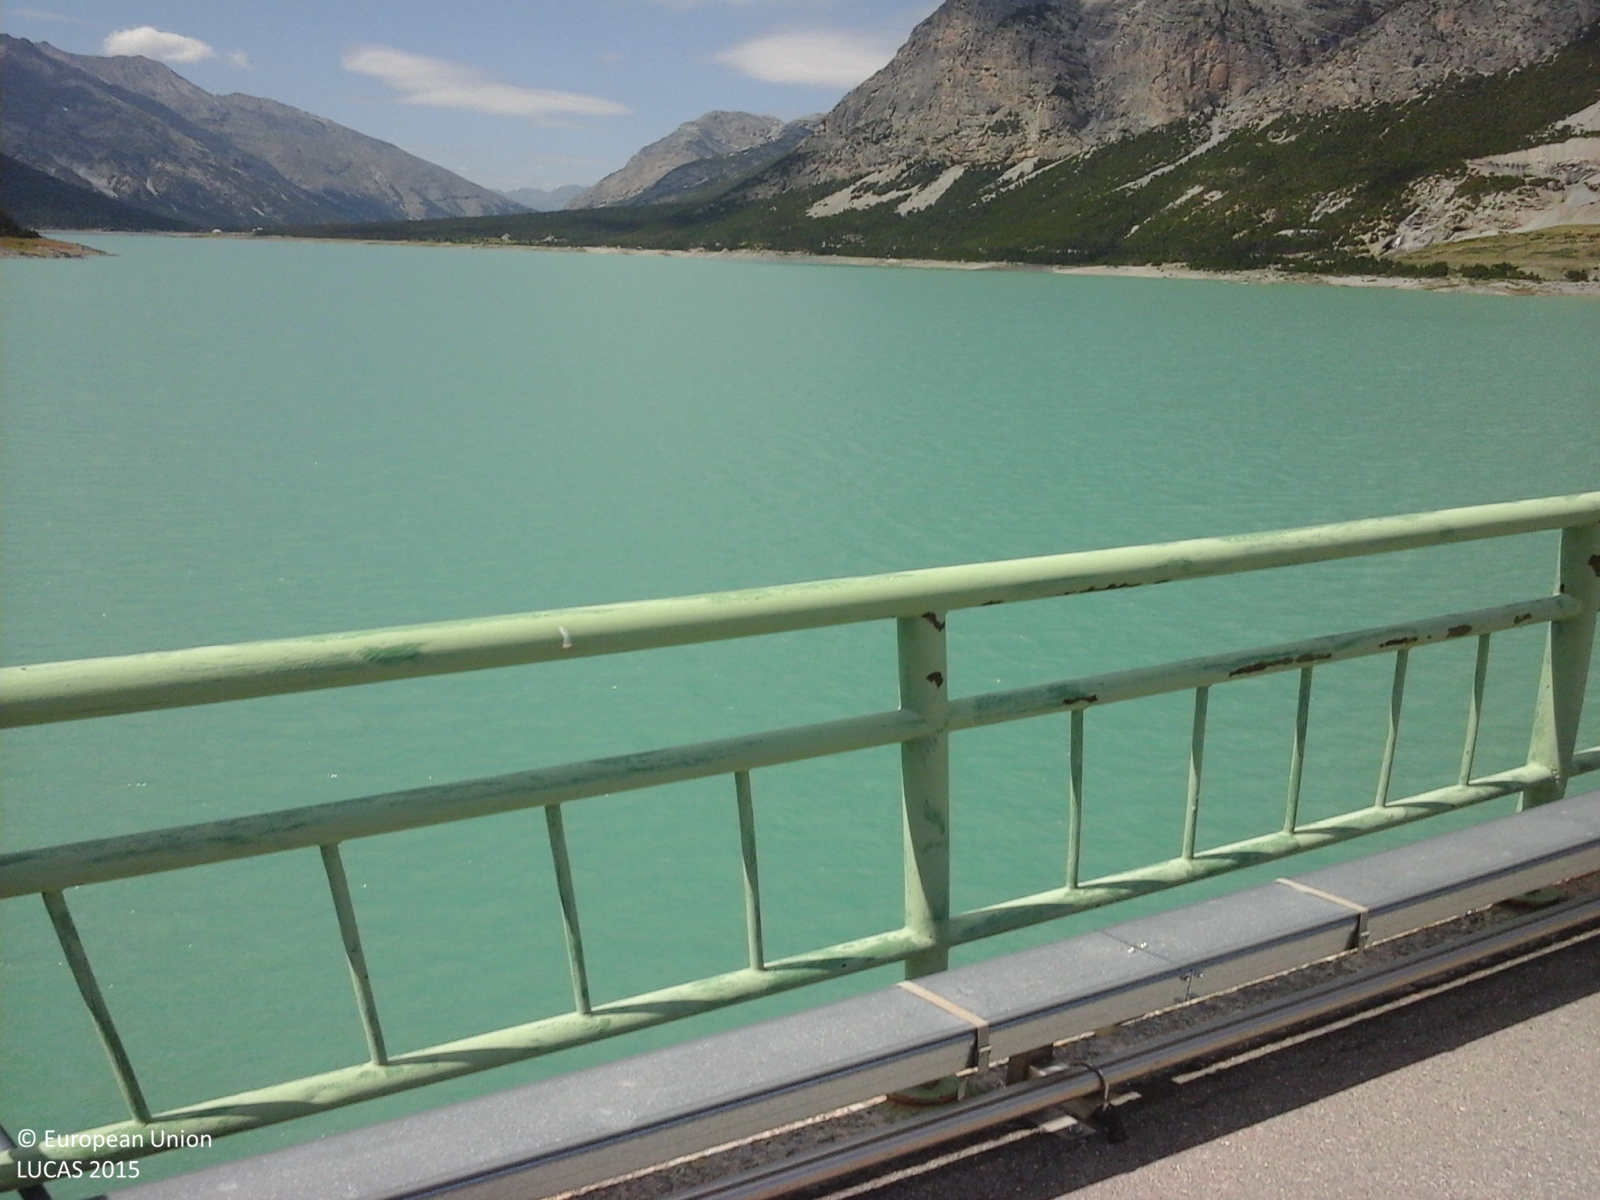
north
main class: Woodland
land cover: Spruce dominated coniferous woodland
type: alpine coniferous forest
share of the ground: > 75 %
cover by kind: coniferous forest trees 100 %
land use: Semi-natural and natural areas not in use
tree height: > 5 m
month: July
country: IT
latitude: 46.5310
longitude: 10.2734
